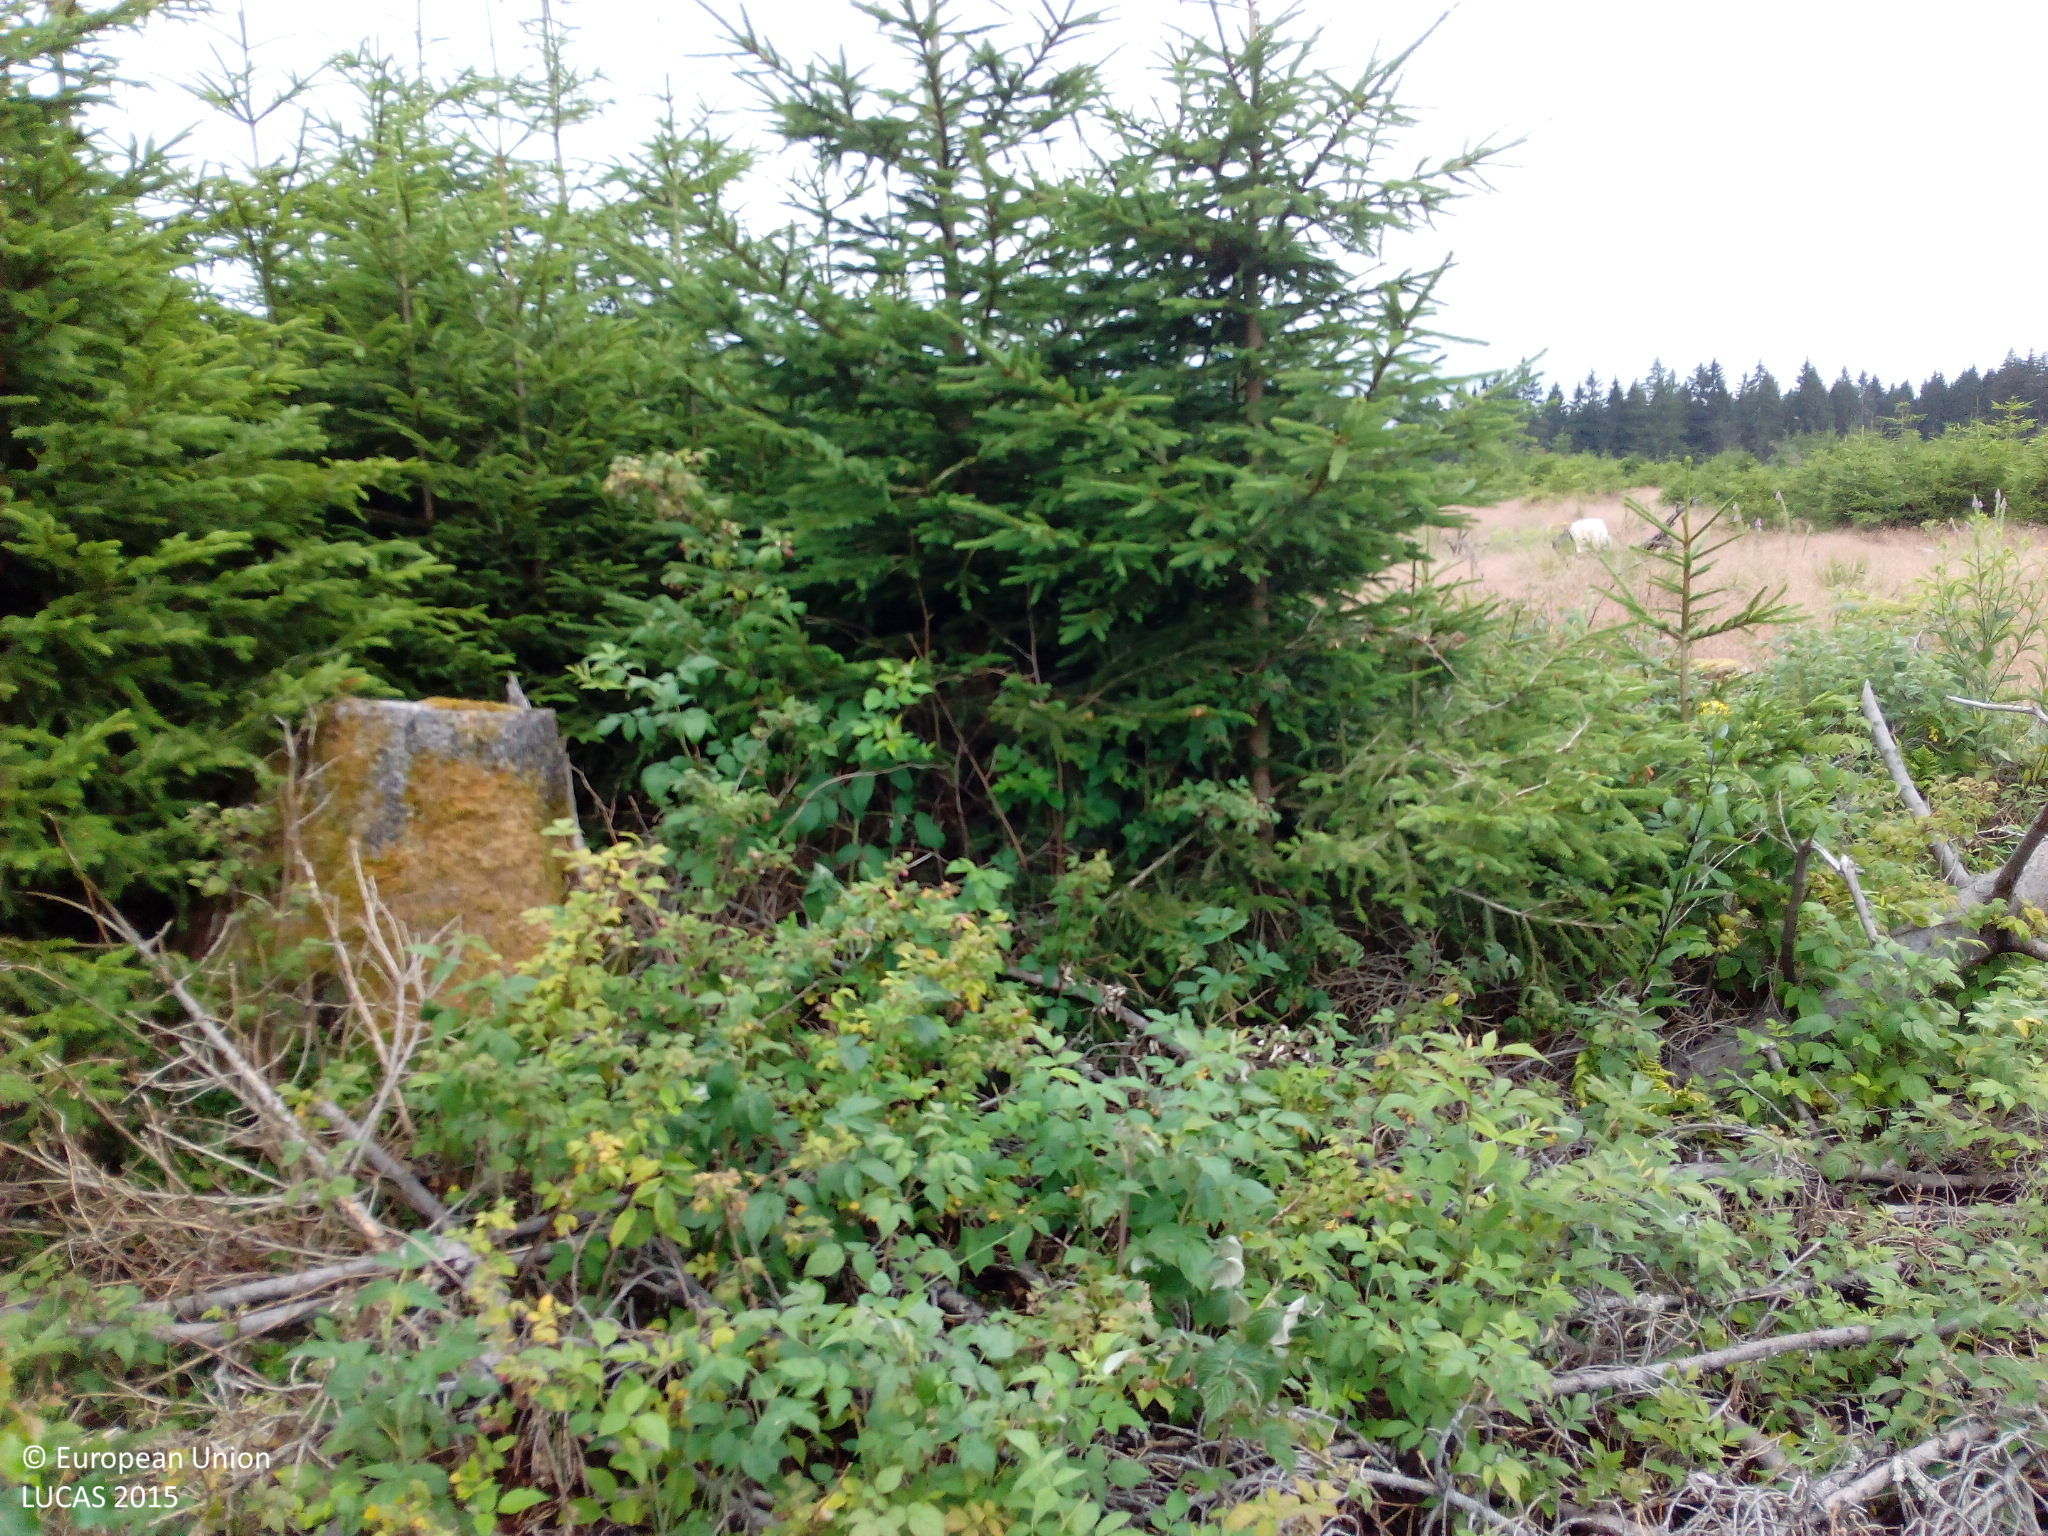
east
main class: Woodland
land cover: Spruce dominated coniferous woodland
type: hemiboreal forest and nemoral coniferous forest and mixed broadleaved-coniferous forest
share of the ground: 25 - 50 %
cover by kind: coniferous forest trees 35 %, herbaceous plants 35 %, unconsolidated bare surface 30 %
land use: Forestry
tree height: < 5 m
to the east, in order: Spruce dominated coniferous woodland; Shrubland with sparse tree cover; Tracks; Shrubland with sparse tree cover; Spruce dominated coniferous woodland; Grassland without tree/shrub cover
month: July
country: DE
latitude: 49.7702
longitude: 7.1261
